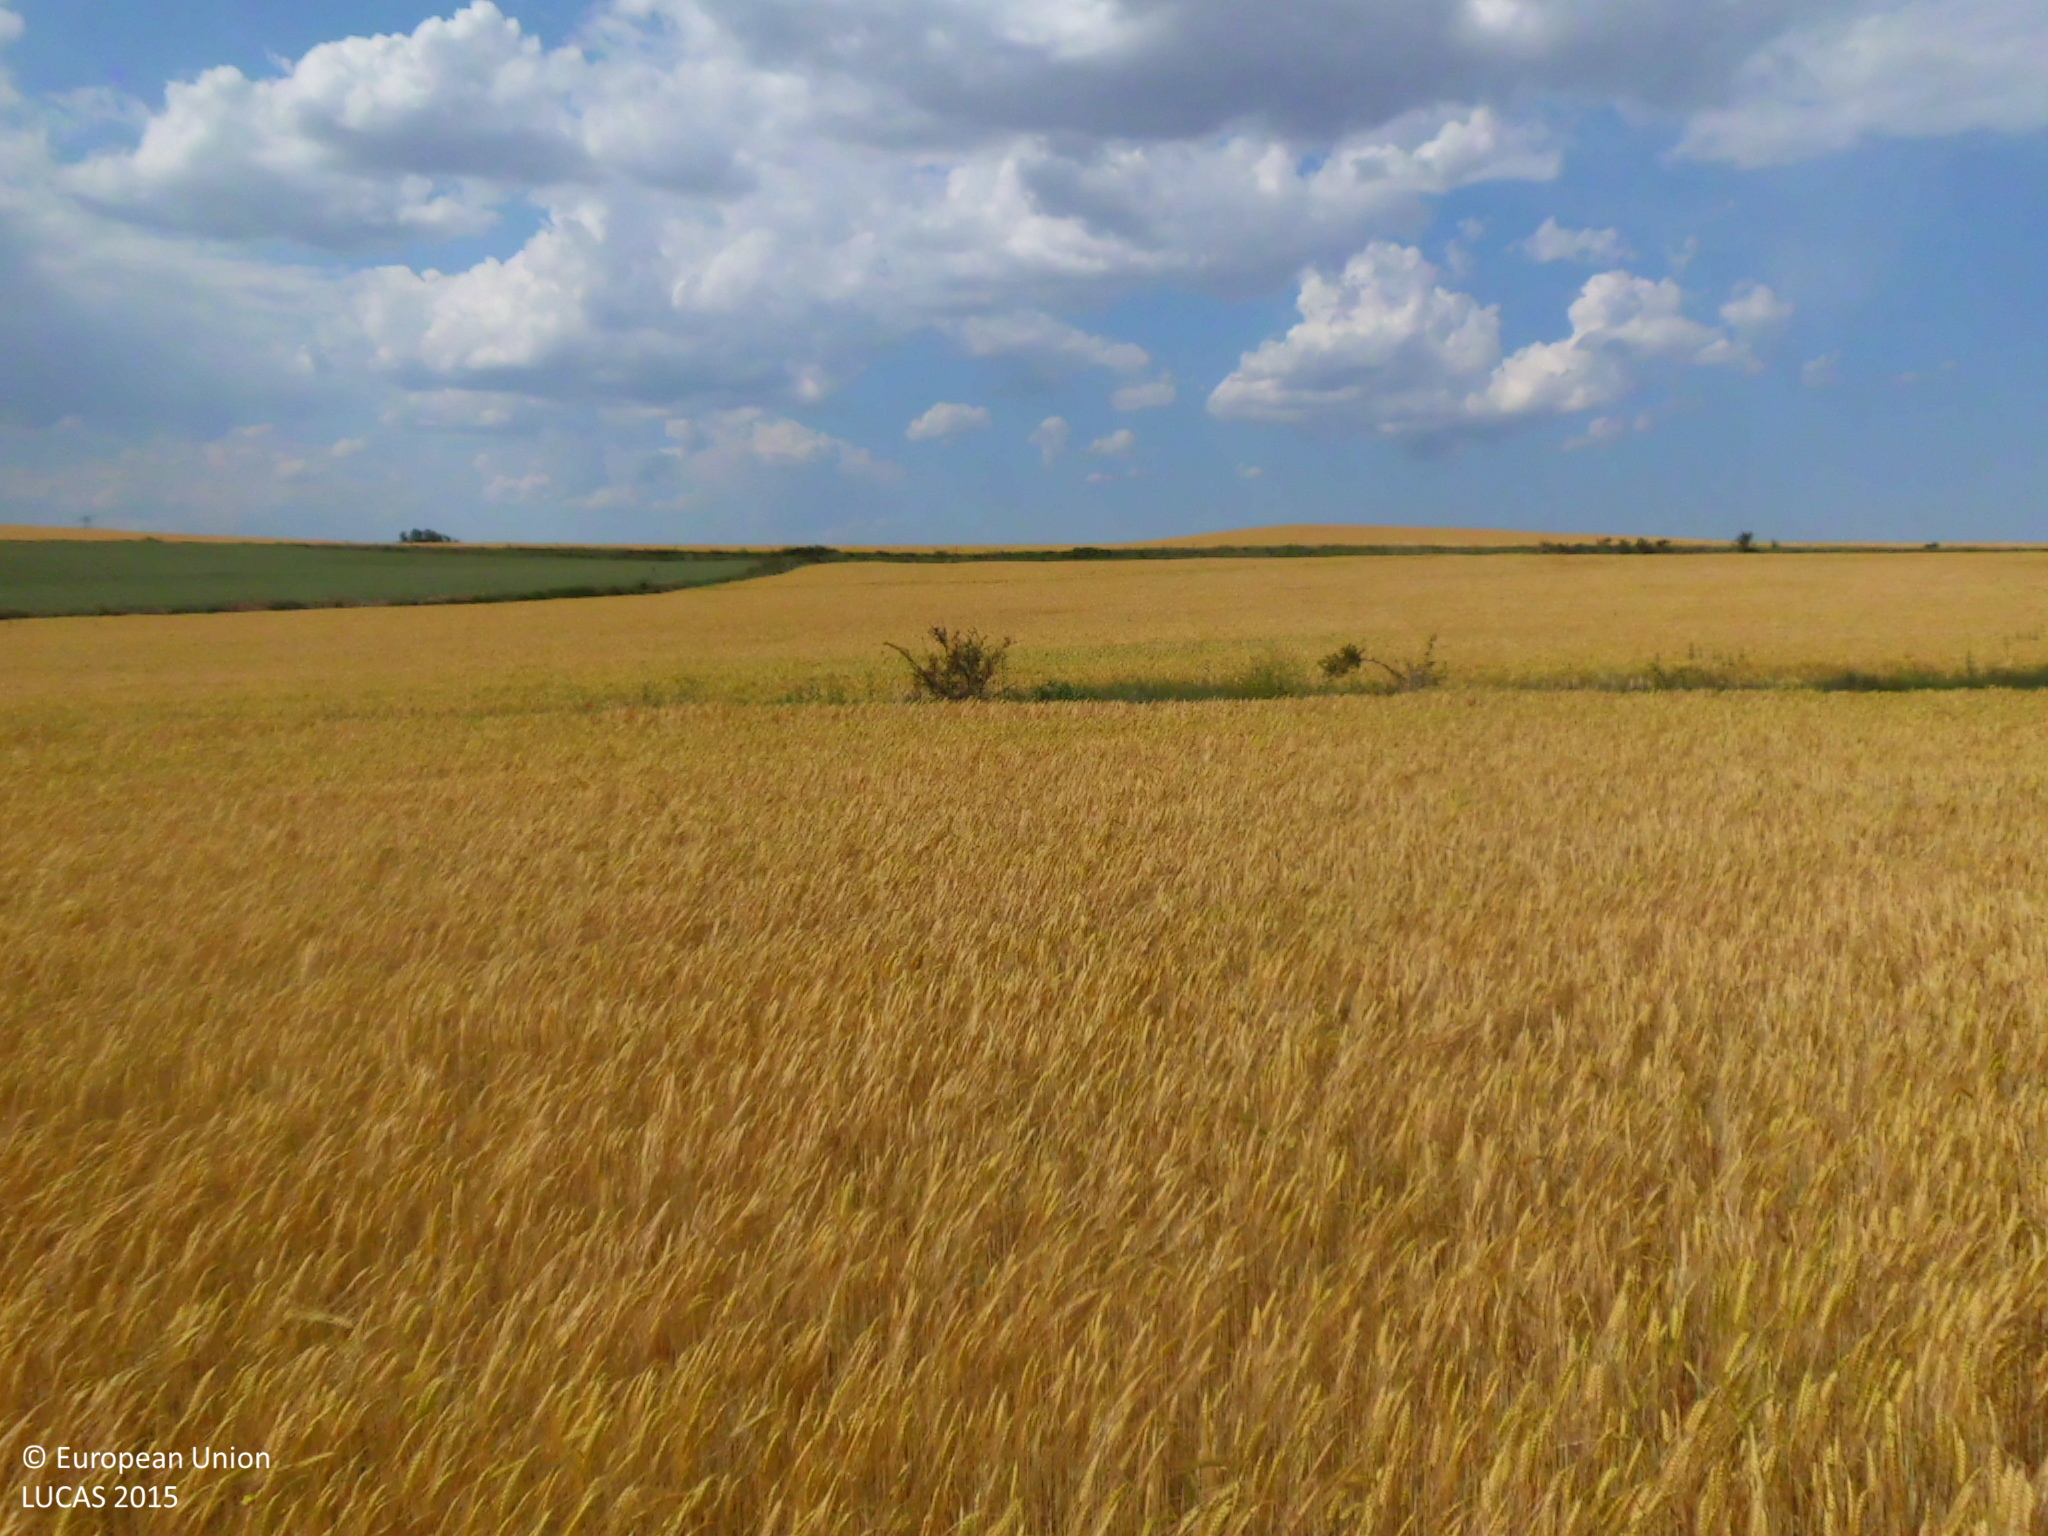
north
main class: Cropland
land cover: Barley
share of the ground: > 75 %
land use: Agriculture (excluding fallow land and kitchen gardens)
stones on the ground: < 10 %
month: June
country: ES
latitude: 42.5232
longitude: -4.3520
